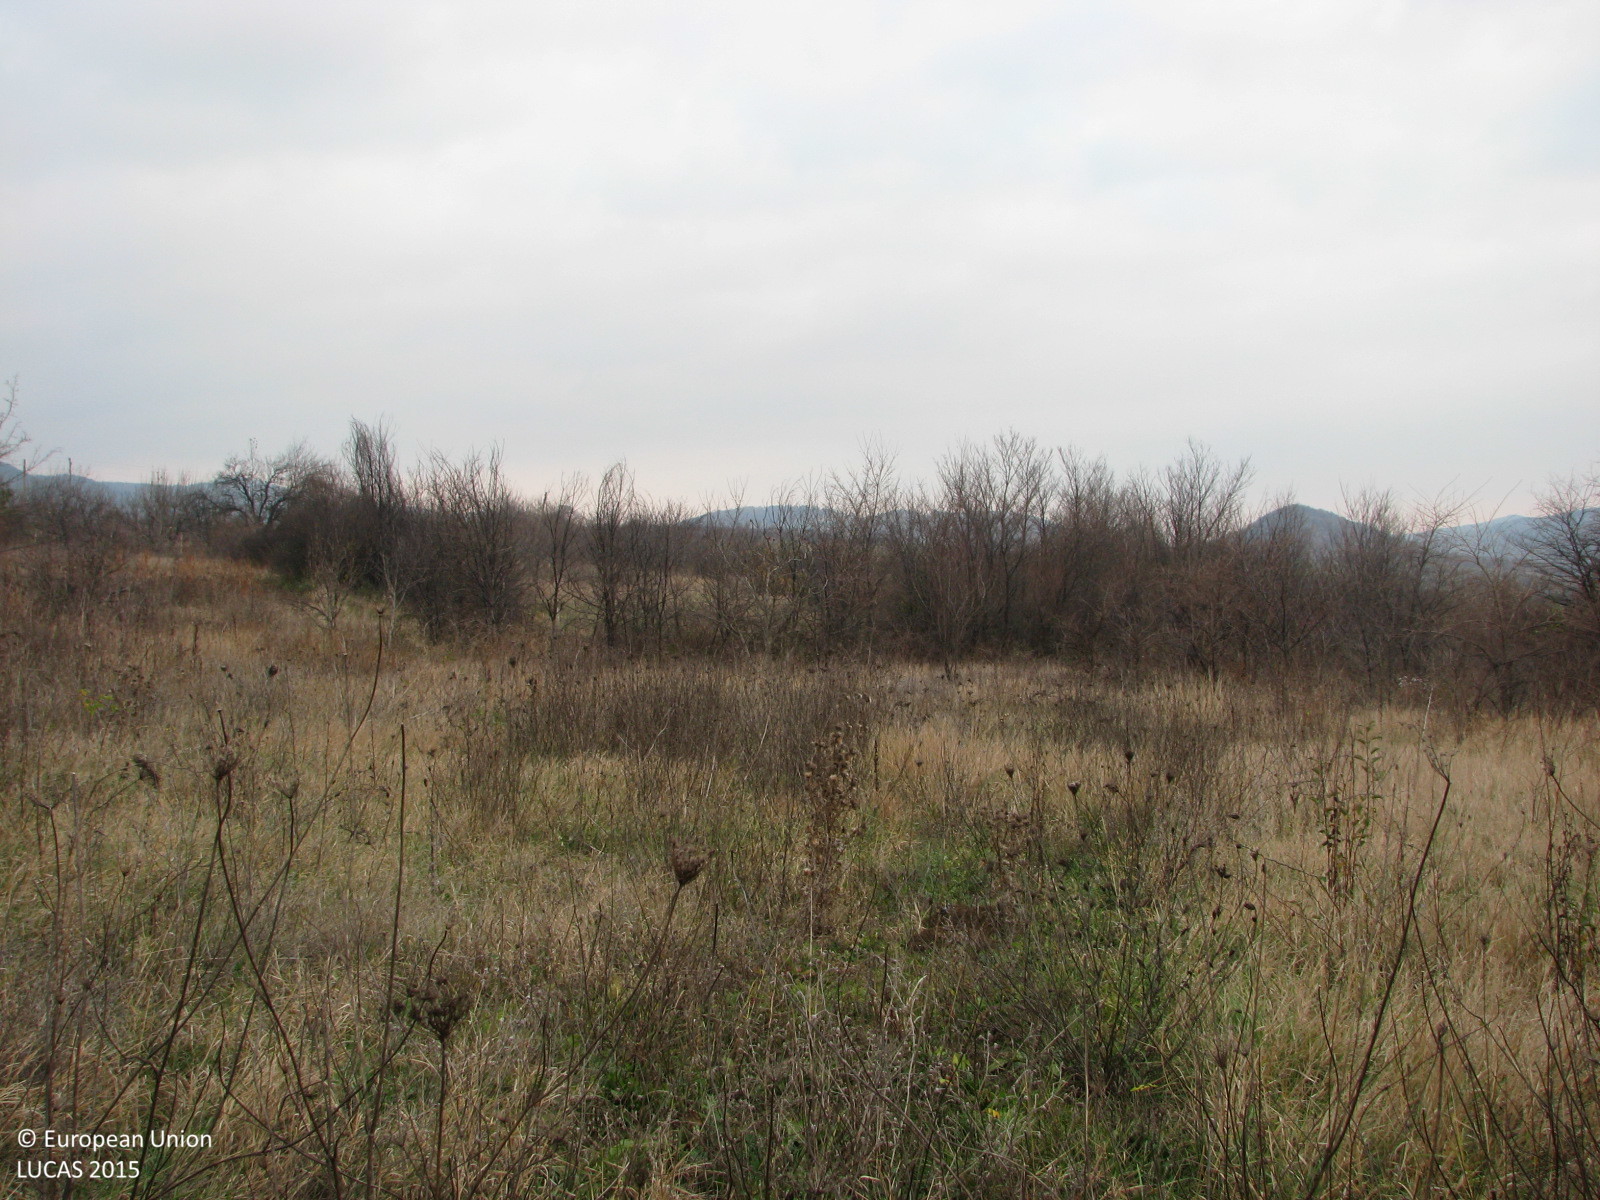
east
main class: Shrubland
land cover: Shrubland with sparse tree cover
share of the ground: 25 - 50 %
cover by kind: herbaceous plants 60 %, shrubs 35 %, broadleaved forest trees 5 %
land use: Fallow land
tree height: < 5 m
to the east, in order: Shrubland with sparse tree cover; Grassland without tree/shrub cover; Other fruit trees and berries; Shrubland without tree cover; Tracks; Common wheat
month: December
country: BG
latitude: 42.4551
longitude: 24.1871
